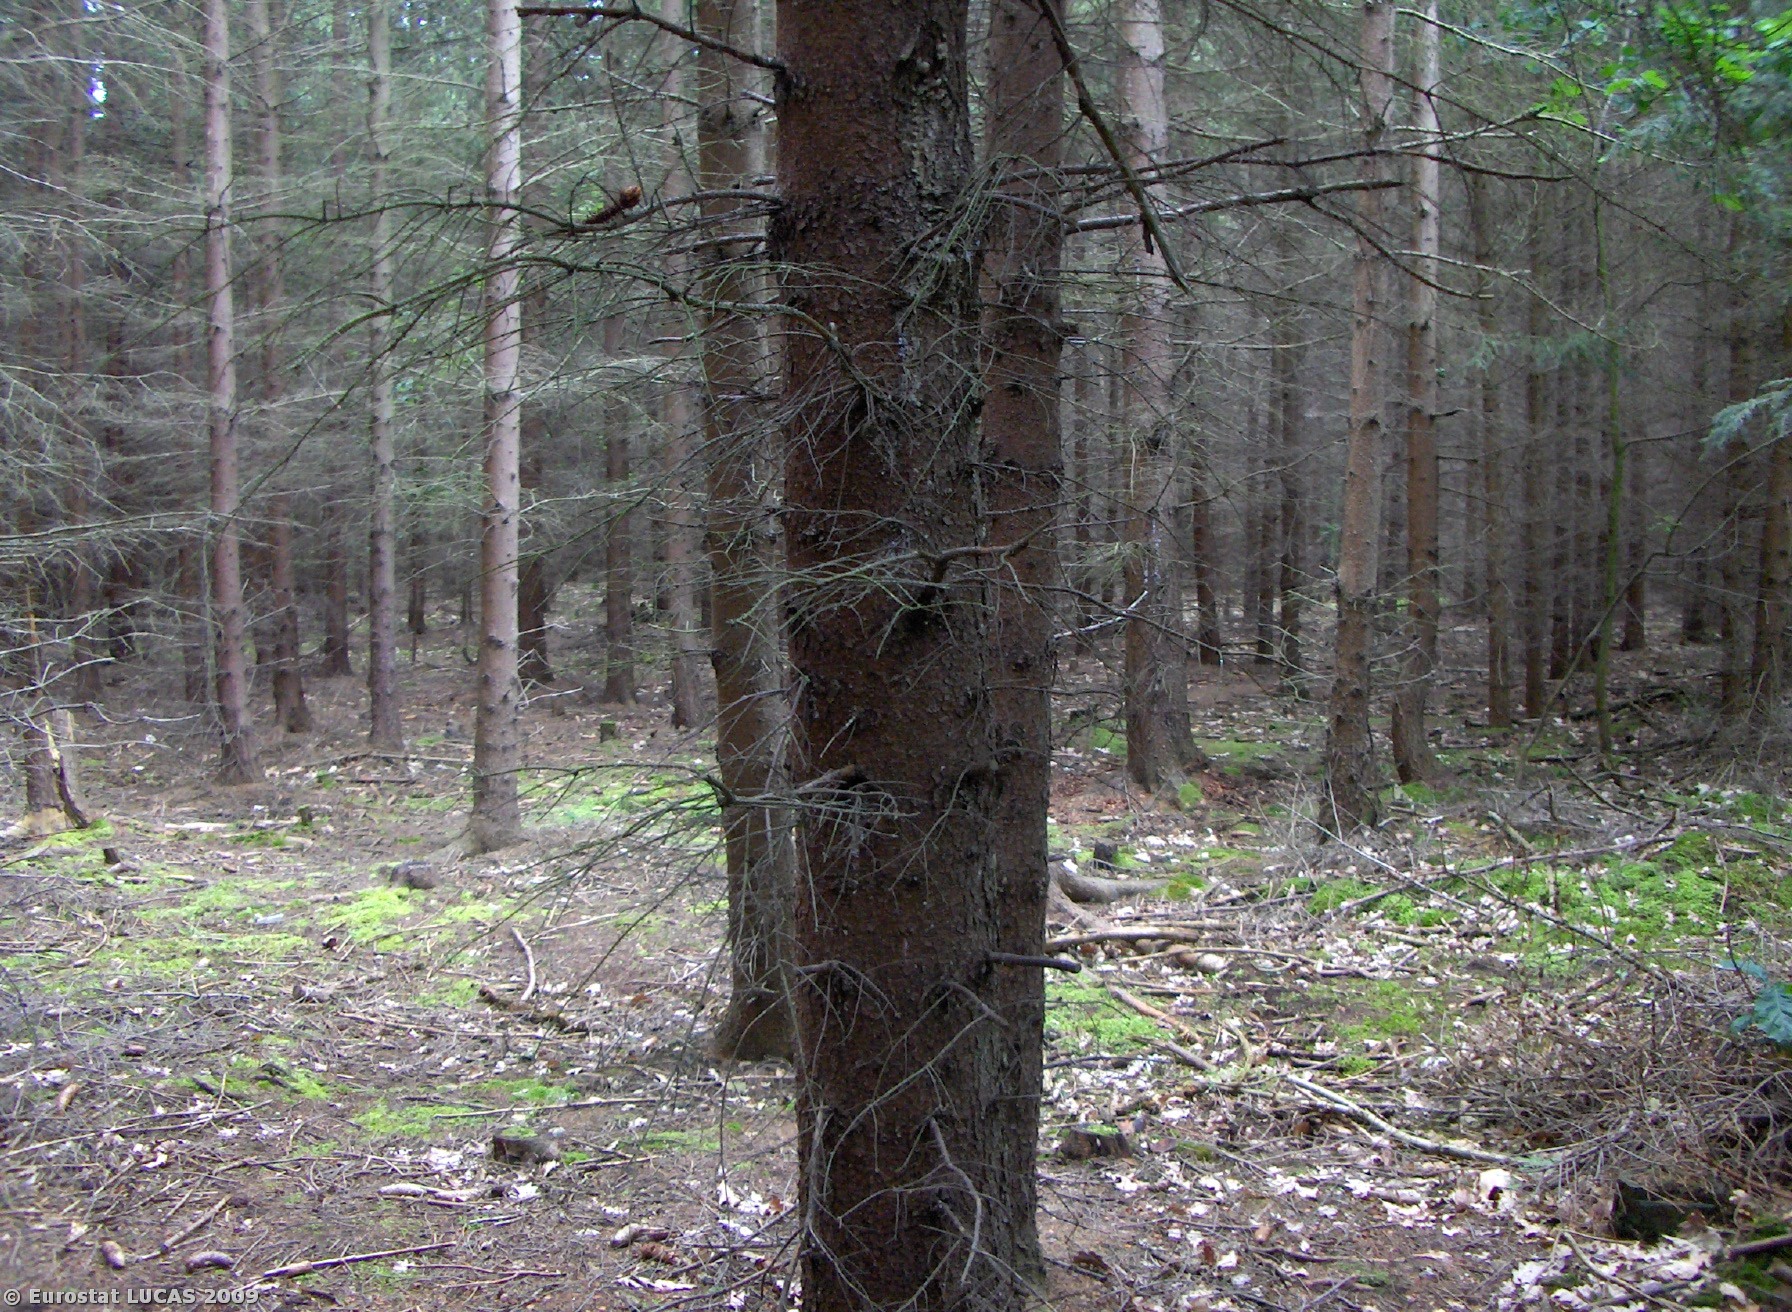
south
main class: Woodland
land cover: Coniferous woodland
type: hemiboreal forest and nemoral coniferous forest and mixed broadleaved-coniferous forest
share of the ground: > 75 %
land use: Forestry
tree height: > 5 m
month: June
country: CZ
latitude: 49.7993
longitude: 14.2386
